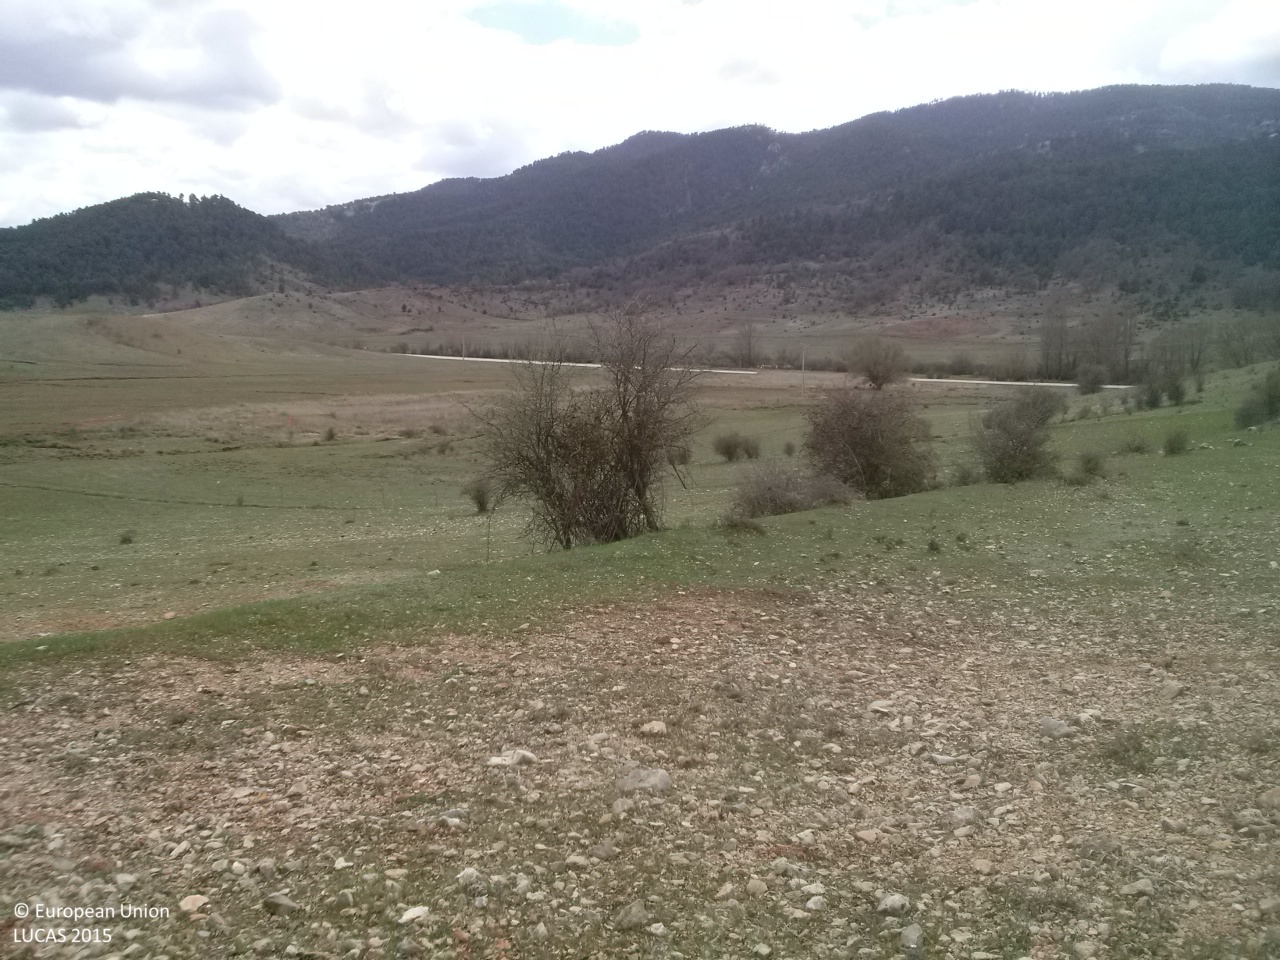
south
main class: Grassland
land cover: Grassland with sparse tree/shrub cover
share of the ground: 50 - 75 %
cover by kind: herbaceous plants 65 %, unconsolidated bare surface 30 %, broadleaved forest trees 5 %
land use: Agriculture (excluding fallow land and kitchen gardens)
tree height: > 5 m
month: April
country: ES
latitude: 40.3352
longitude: -1.8224
